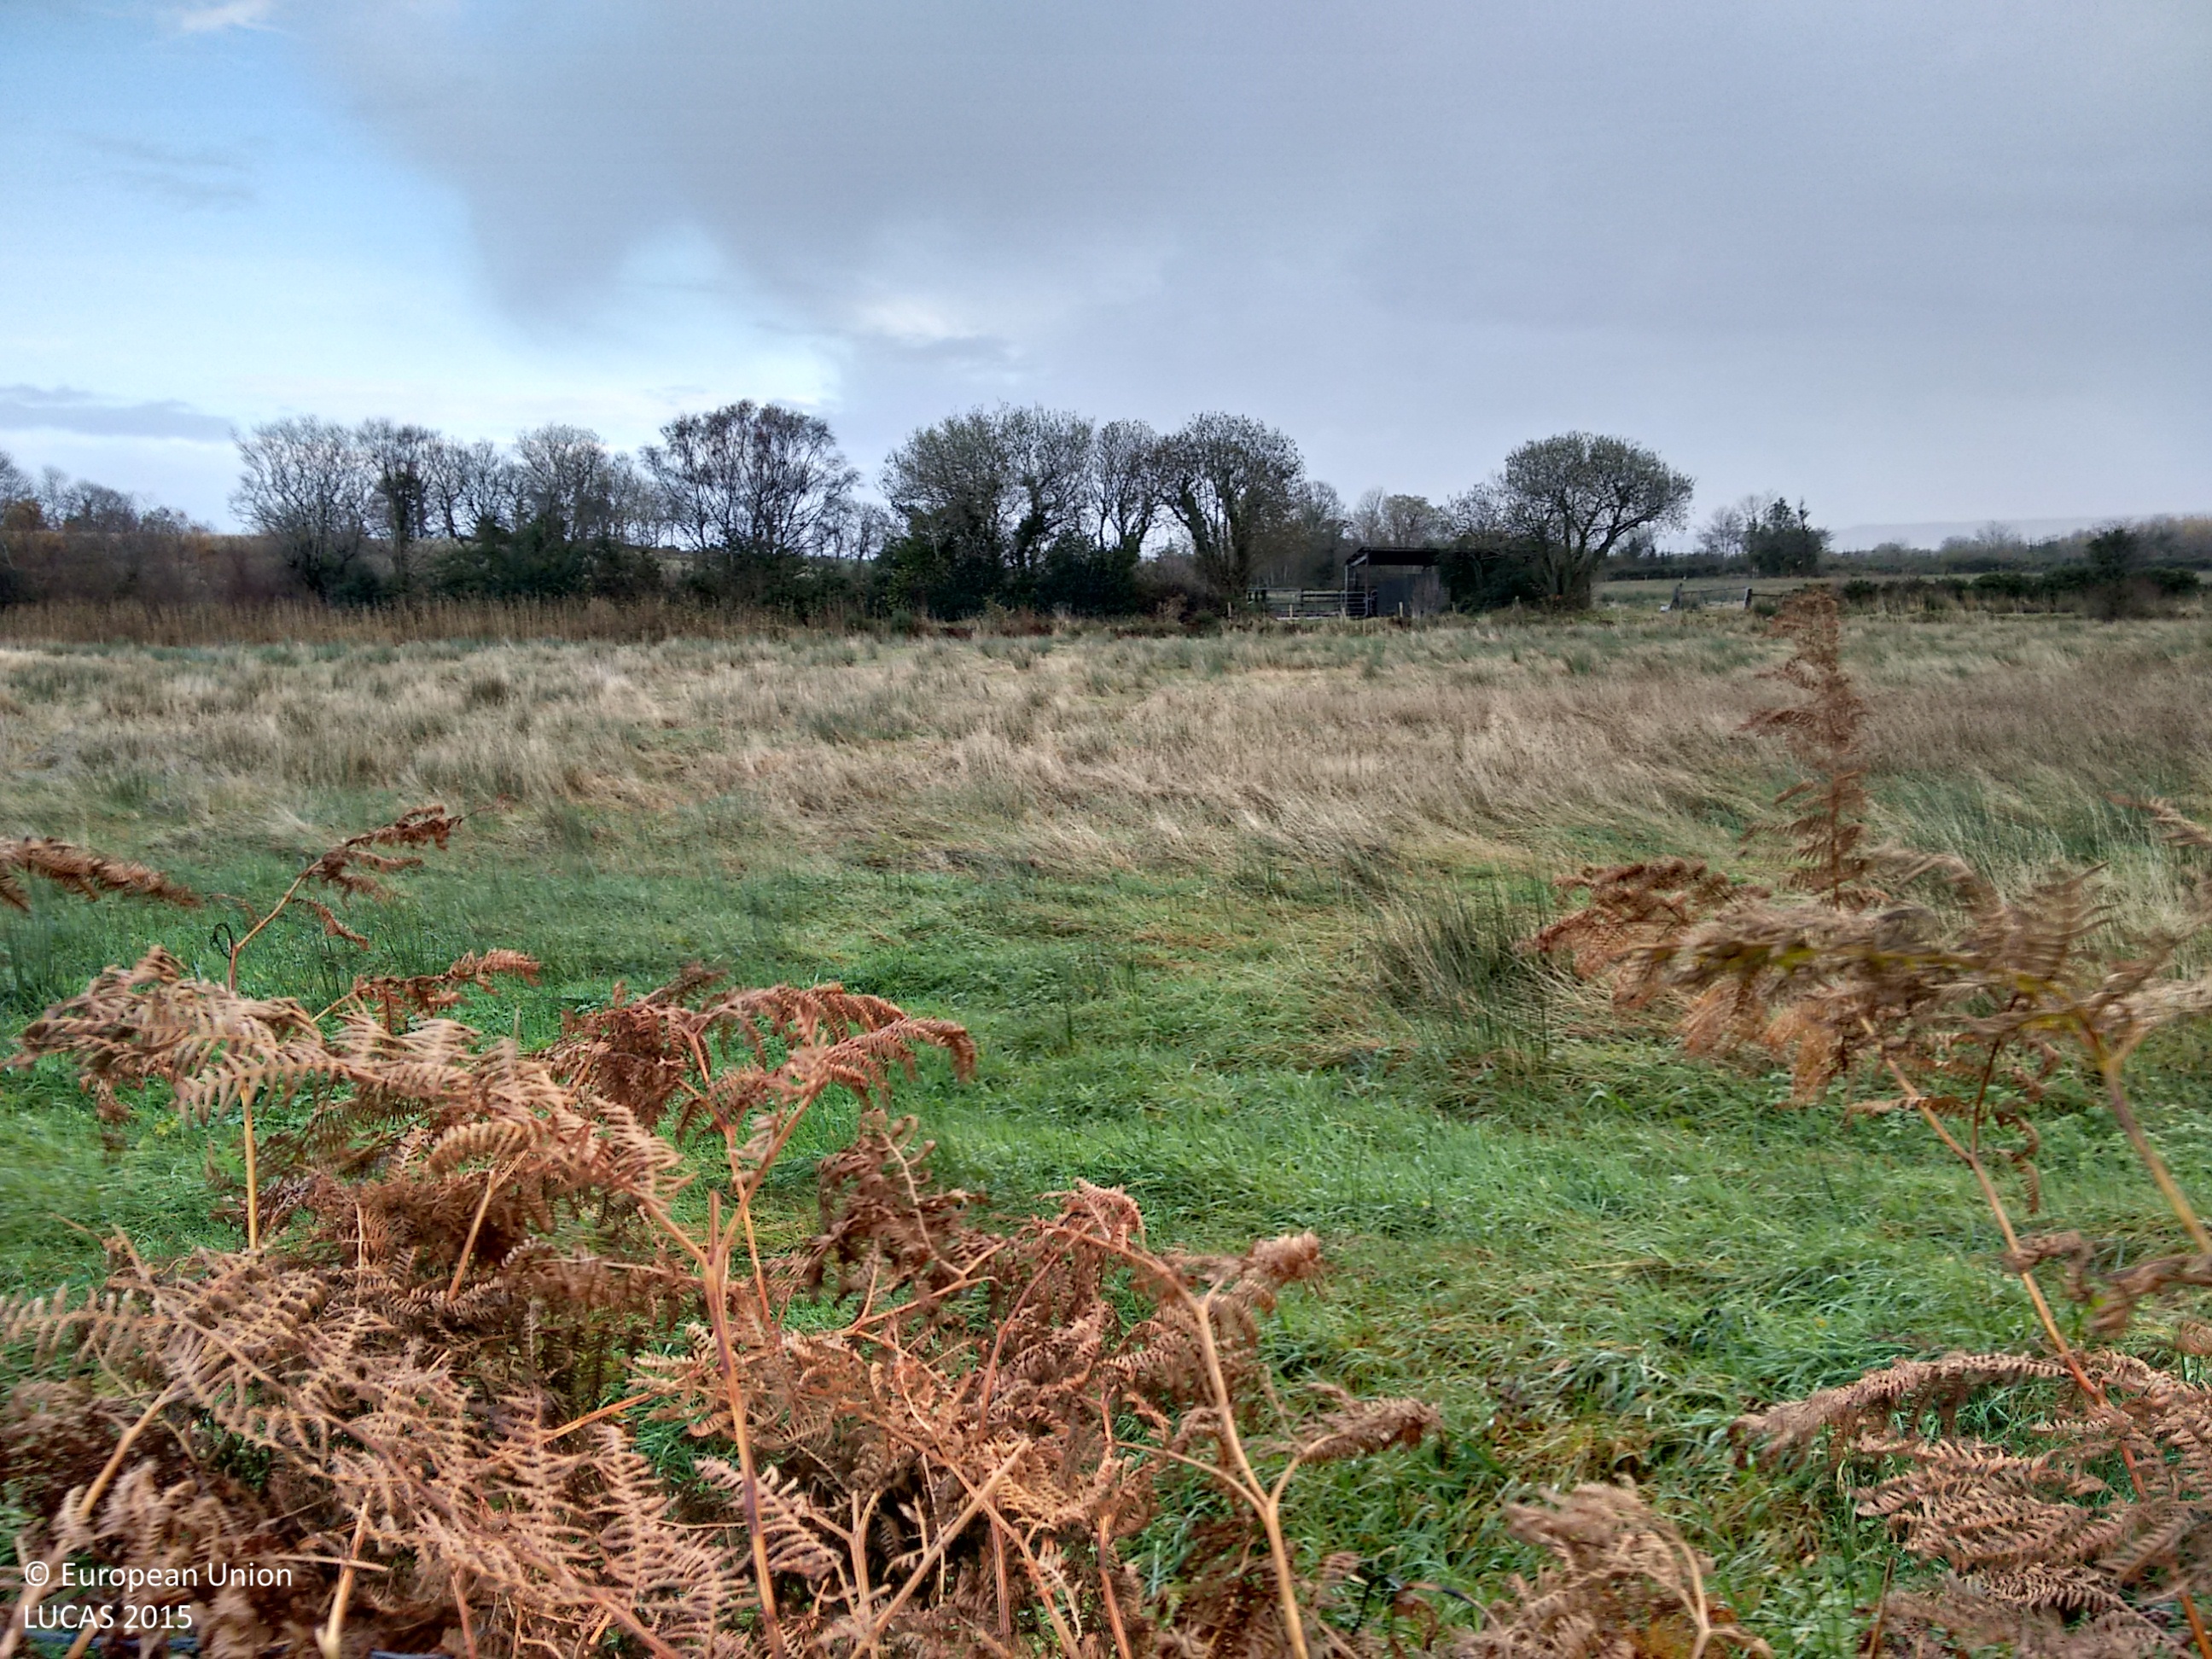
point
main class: Grassland
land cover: Grassland without tree/shrub cover
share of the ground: > 75 %
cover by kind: herbaceous plants 100 %
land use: Agriculture (excluding fallow land and kitchen gardens)
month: November
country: IE
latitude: 54.4732
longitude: -8.1240
